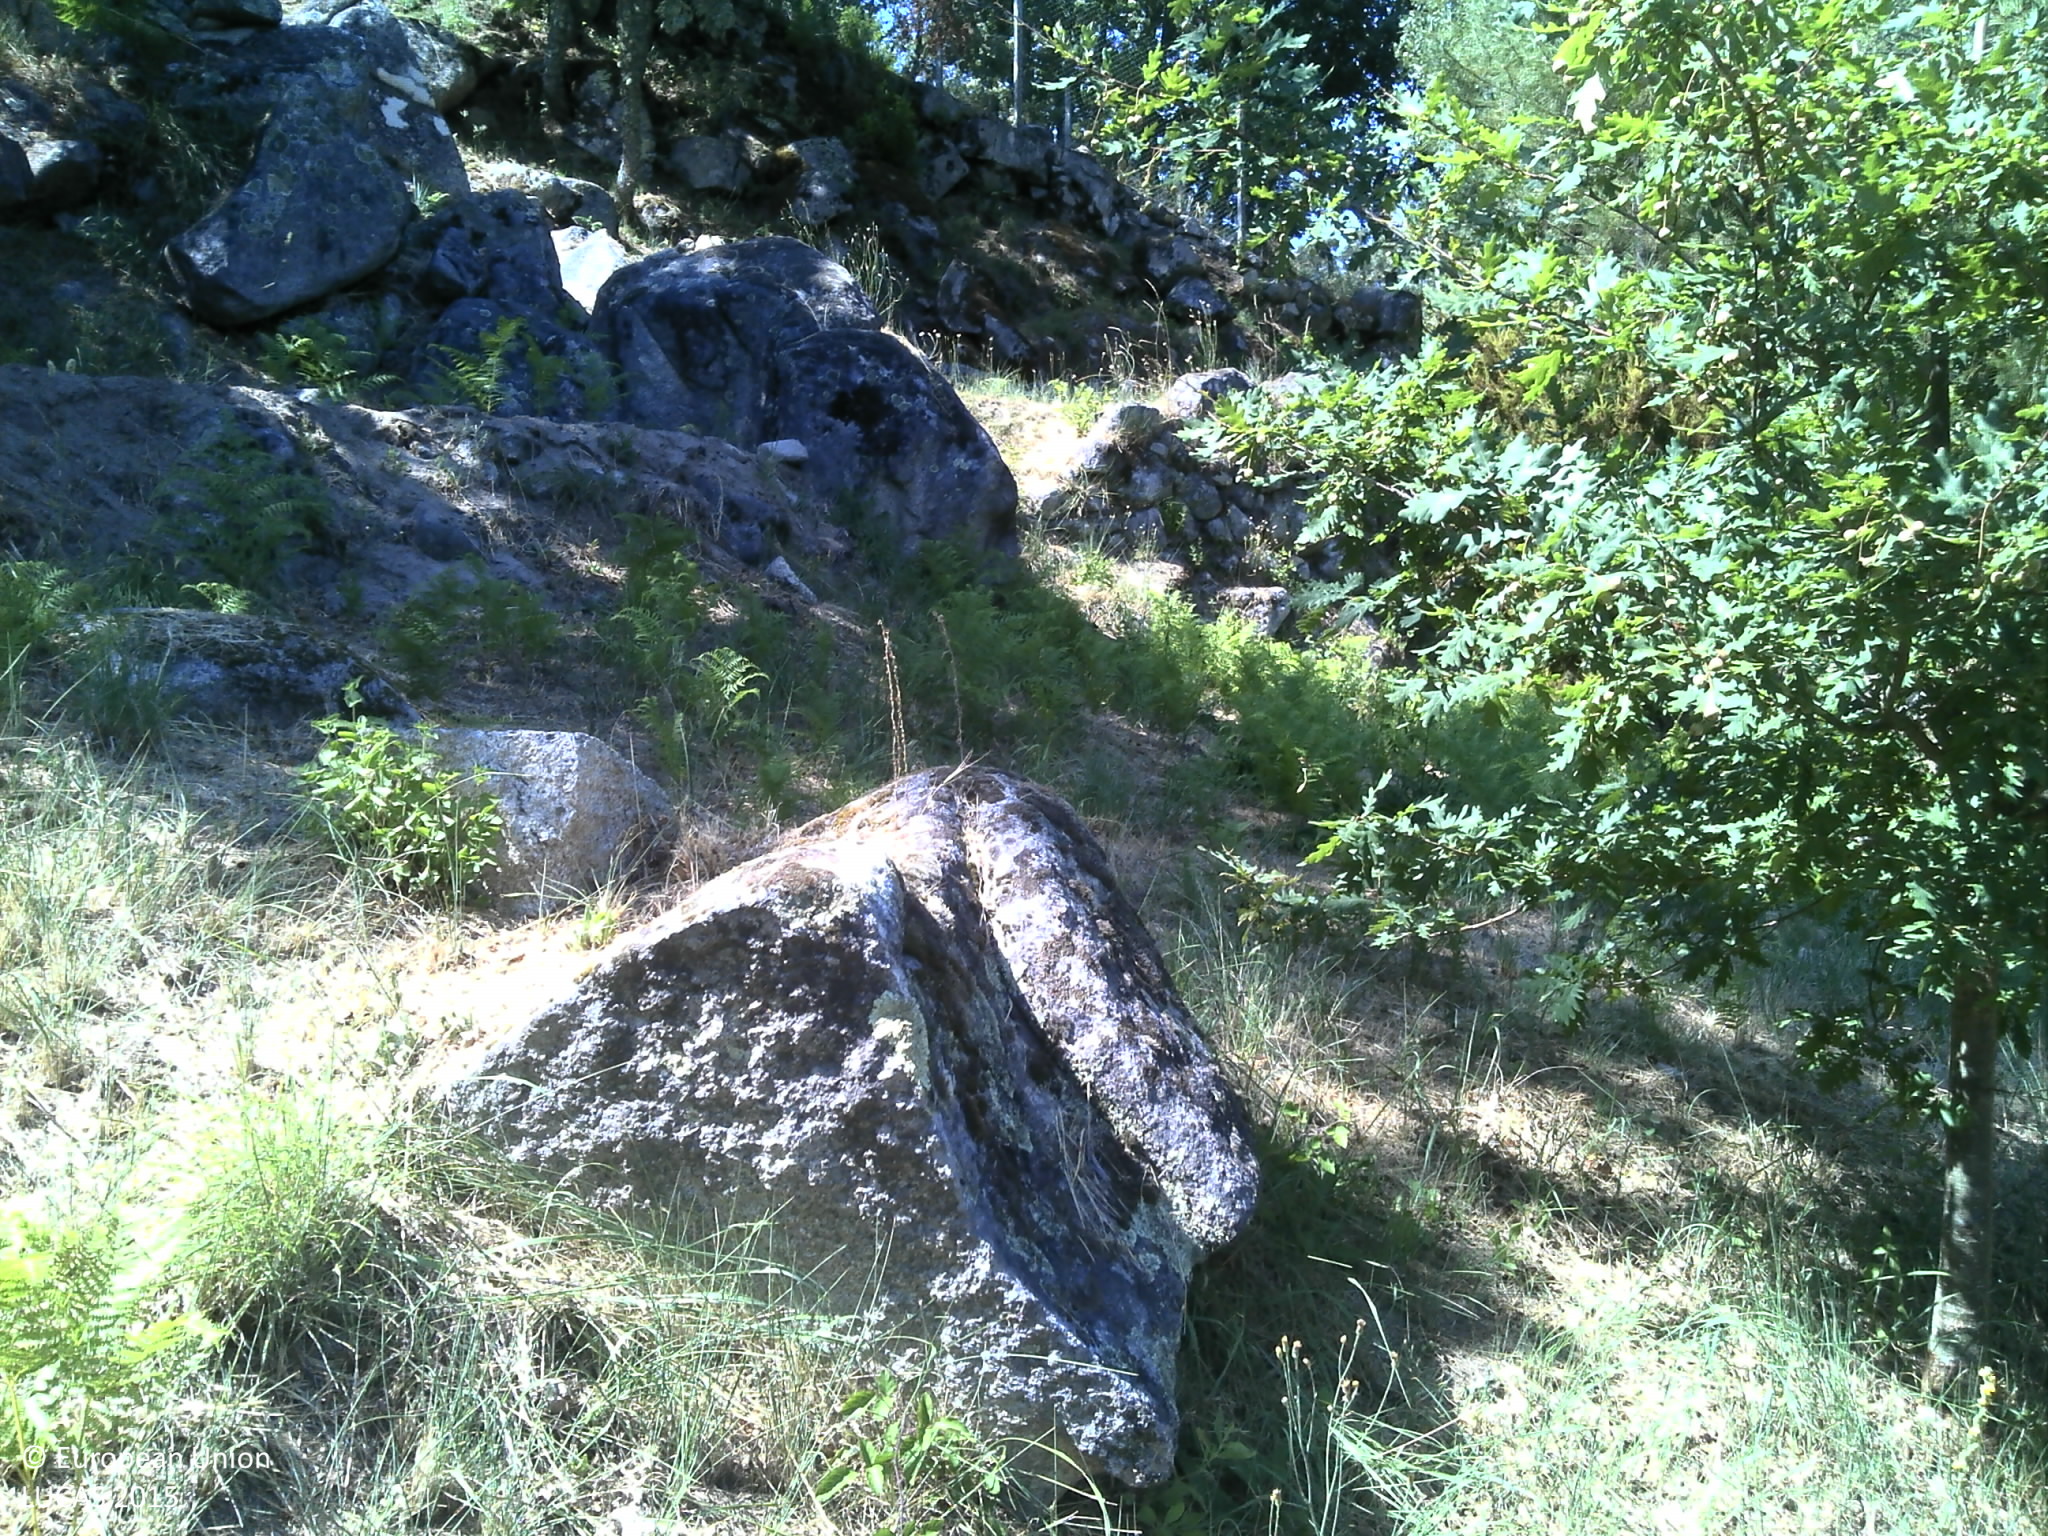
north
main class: Woodland
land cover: Broadleaved woodland
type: thermophilous deciduous forest
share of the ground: 25 - 50 %
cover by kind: broadleaved forest trees 45 %, herbaceous plants 40 %, consolidated bare surface 10 %, shrubs 5 %
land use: Forestry
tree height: < 5 m
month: July
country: PT
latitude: 40.3062
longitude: -7.8962
